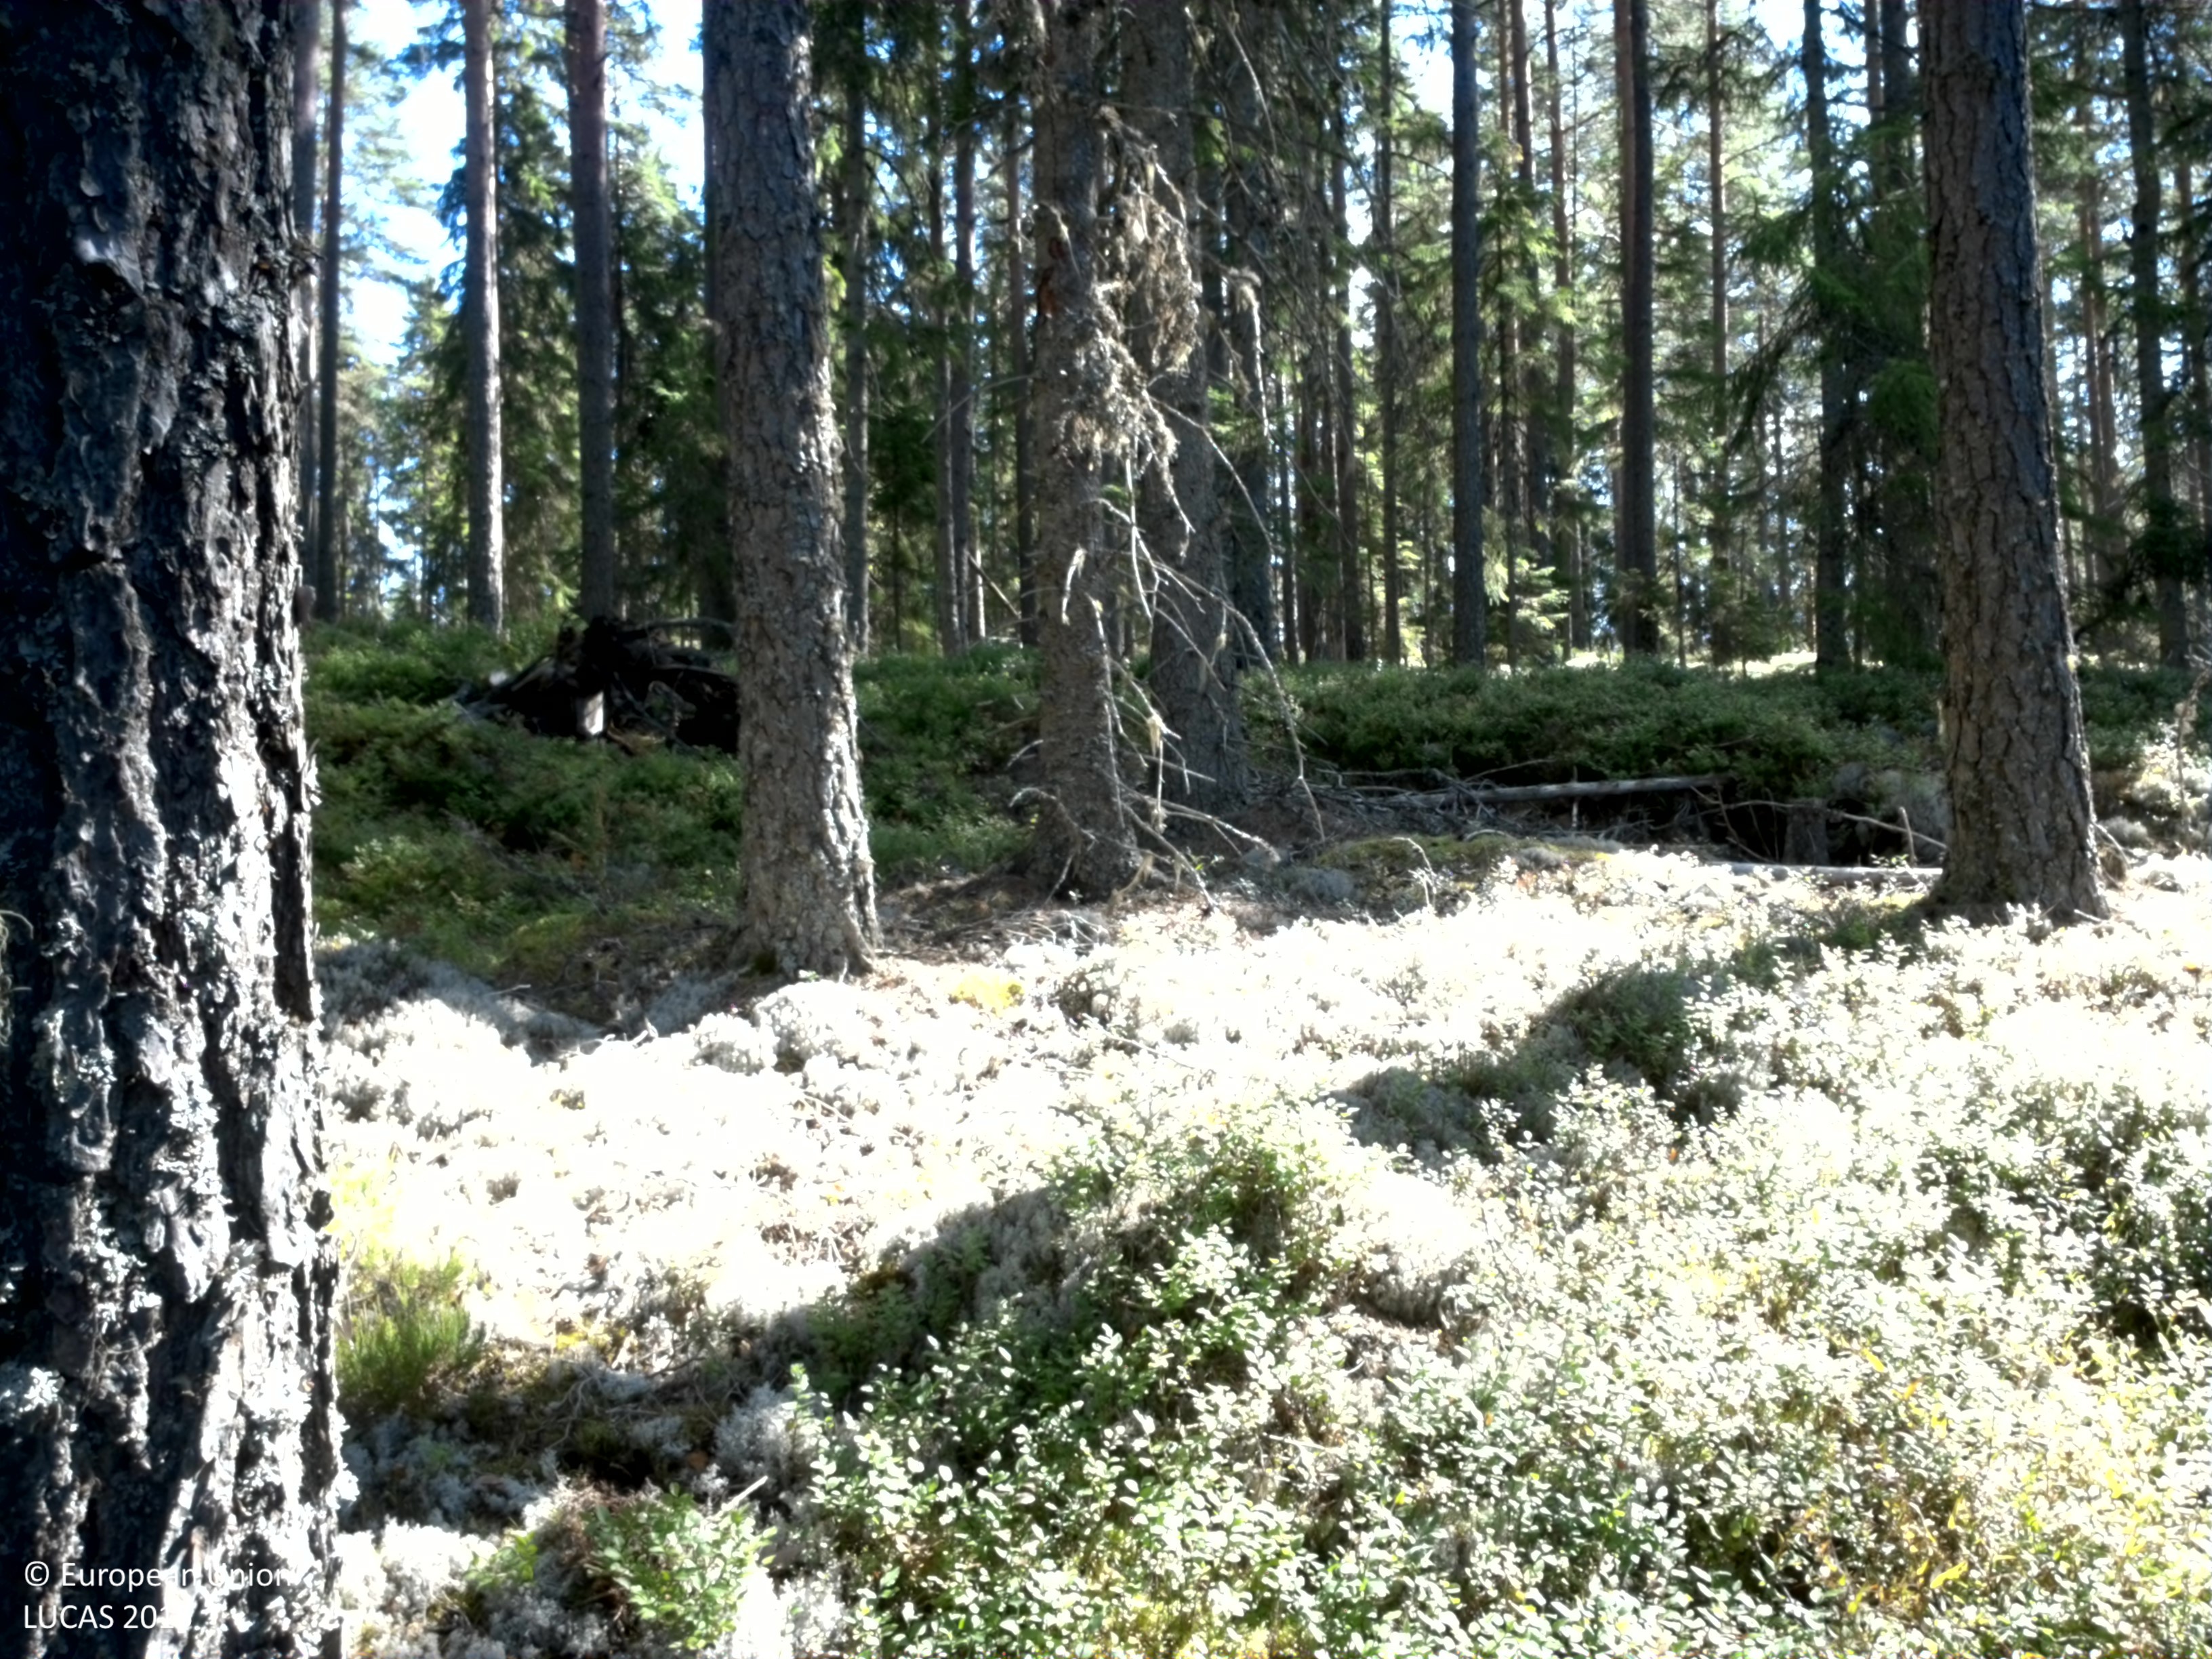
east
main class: Woodland
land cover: Pine dominated coniferous woodland
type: boreal forest
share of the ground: 50 - 75 %
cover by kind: coniferous forest trees 70 %, shrubs 20 %, lichens and mosses 10 %
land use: Forestry
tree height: > 5 m
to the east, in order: Pine dominated coniferous woodland; Spruce dominated coniferous woodland
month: August
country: SE
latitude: 60.1740
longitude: 13.4693
